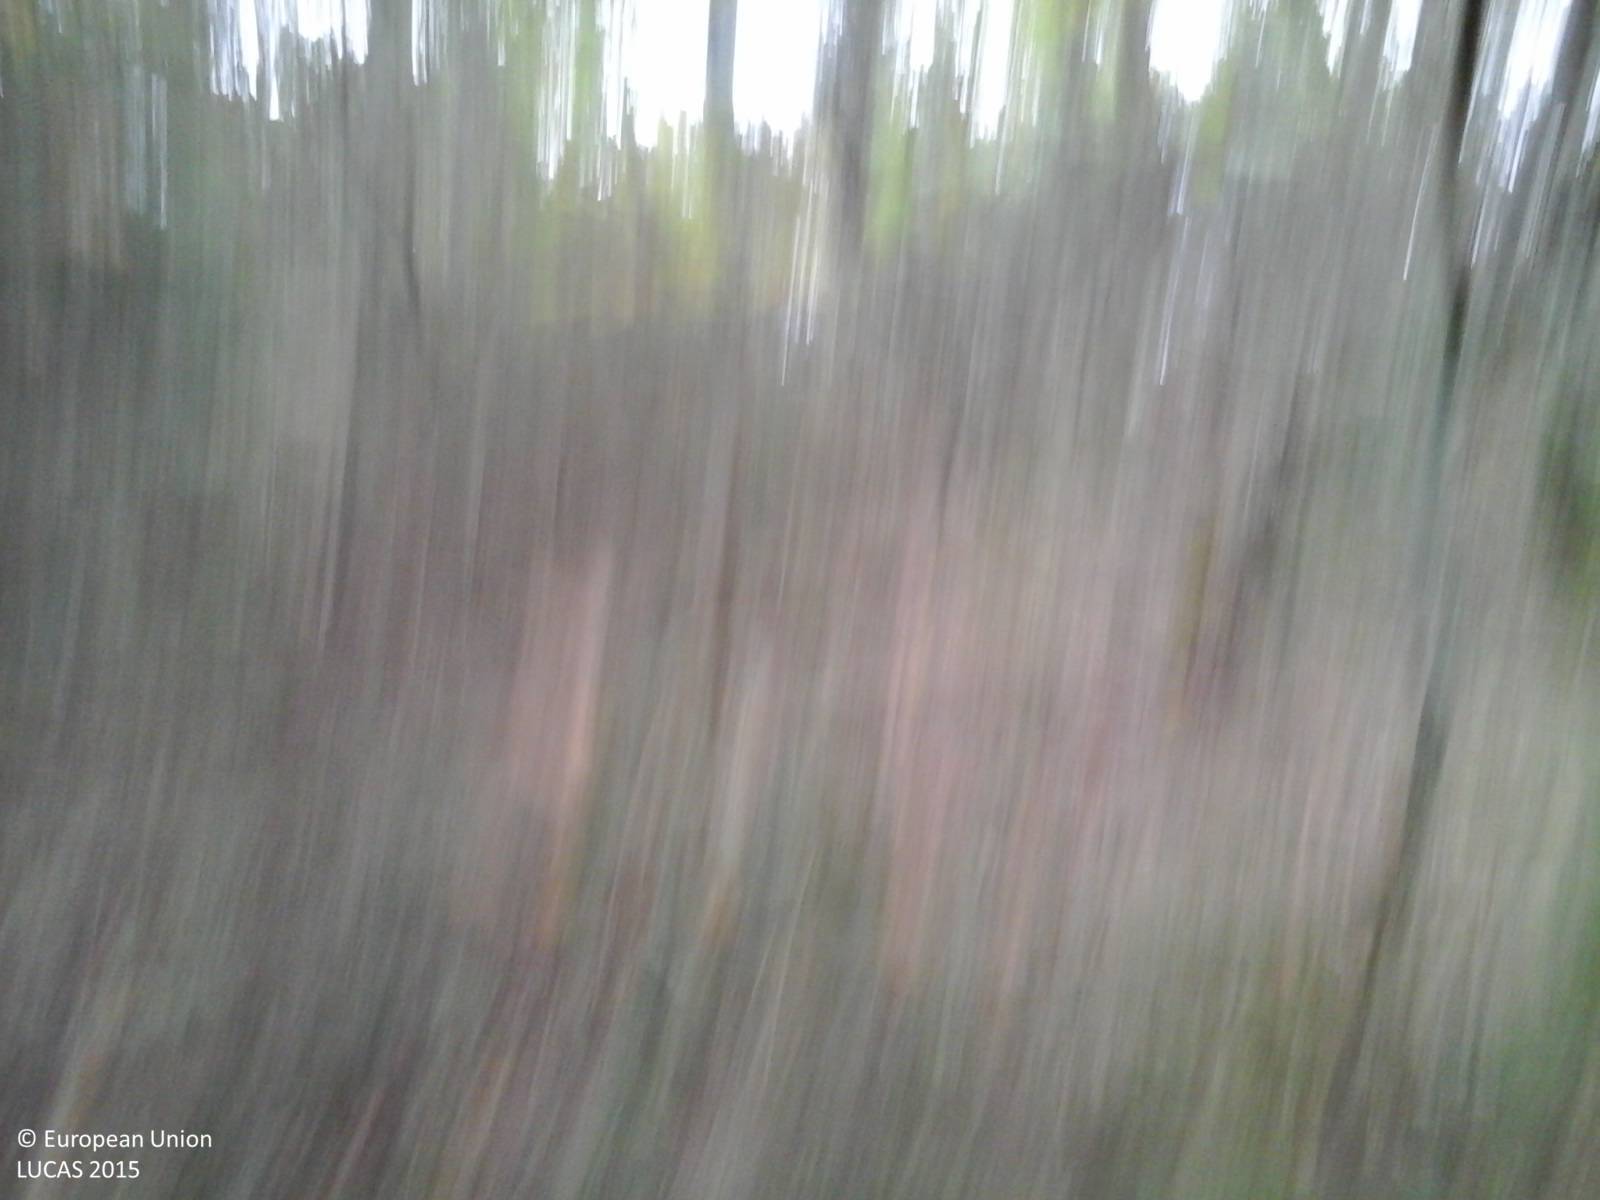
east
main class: Woodland
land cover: Broadleaved woodland
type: thermophilous deciduous forest
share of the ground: > 75 %
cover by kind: broadleaved forest trees 75 %, shrubs 25 %
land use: Forestry
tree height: > 5 m
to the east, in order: Broadleaved woodland; Lines of trees; Shrubland with sparse tree cover; Lines of trees; Grass margins; Lines of trees; Grassland without tree/shrub cover; Lines of trees; Grass margins; Paved roads, cycling and walking lanes; Grass margins; Olive groves; Abandoned hedges; Olive groves; Abandoned hedges; Olive groves; Abandoned hedges; Olive groves
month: October
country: IT
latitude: 43.3451
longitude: 11.6360
